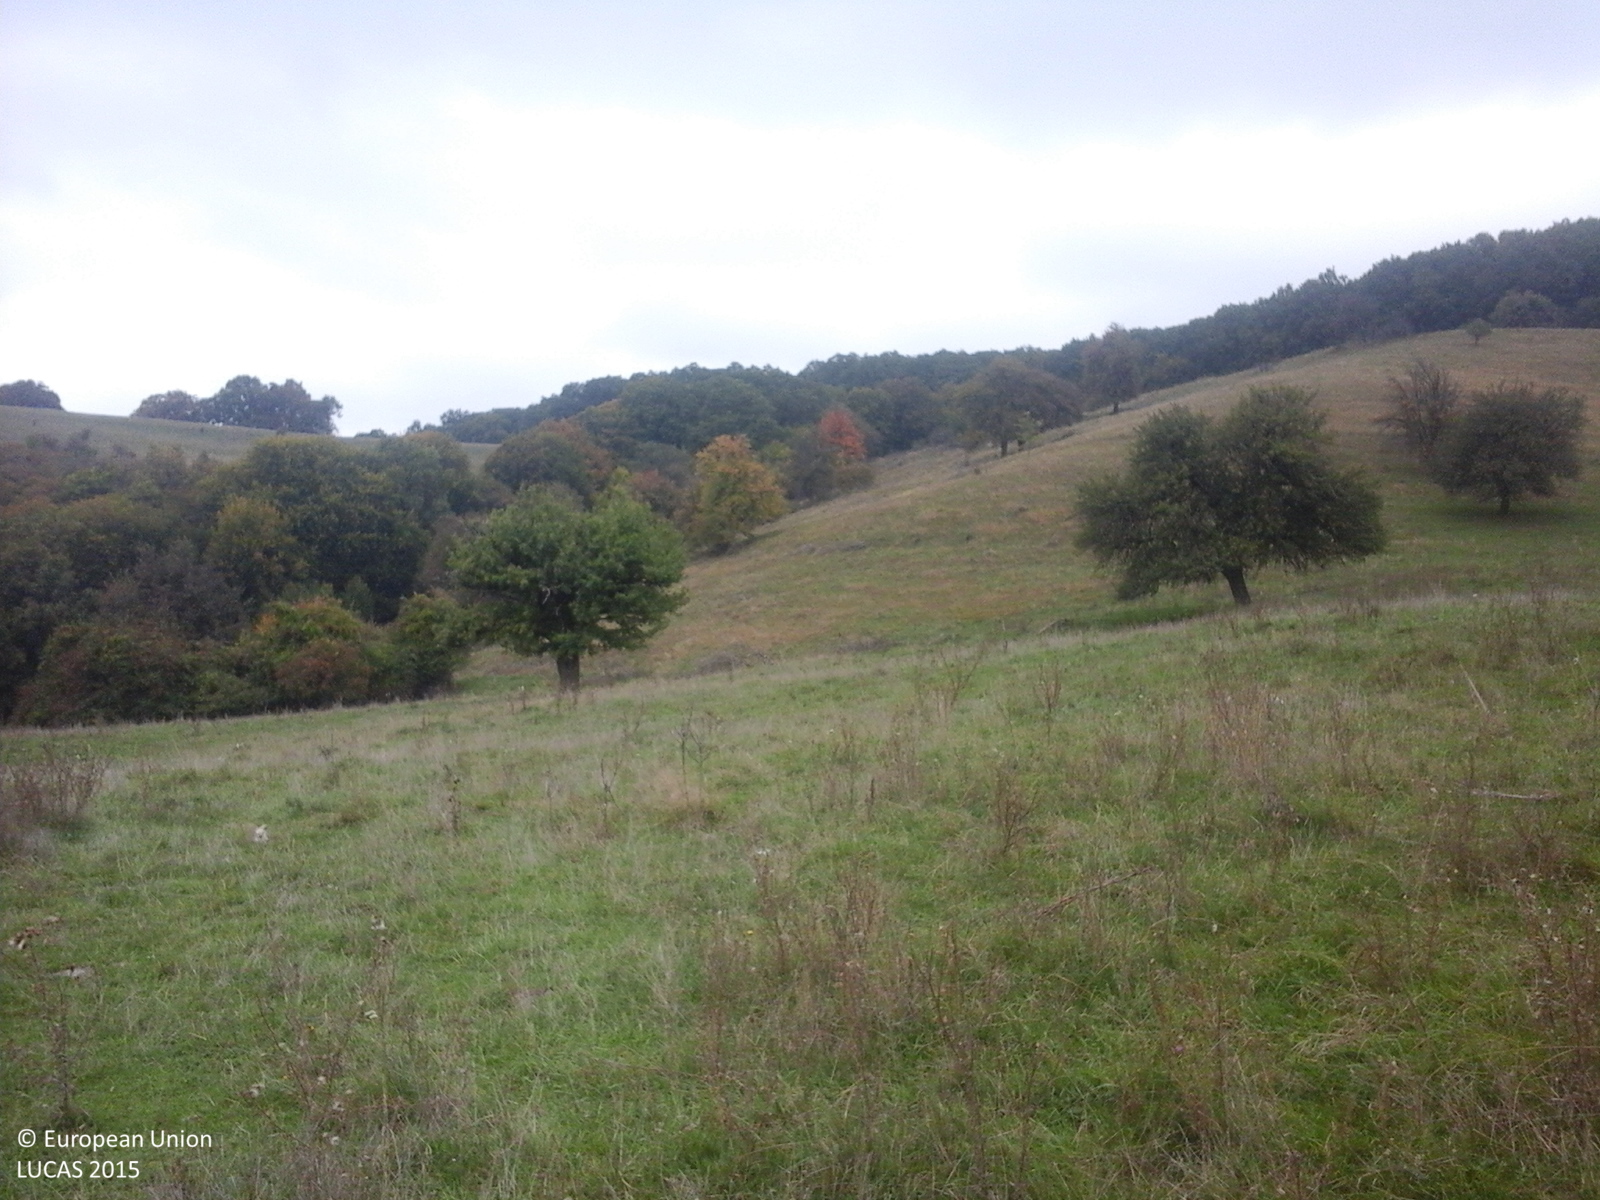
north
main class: Grassland
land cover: Grassland without tree/shrub cover
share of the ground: > 75 %
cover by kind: herbaceous plants 100 %
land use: Agriculture (excluding fallow land and kitchen gardens)
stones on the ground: < 10 %
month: October
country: RO
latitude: 46.1789
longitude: 24.8996
